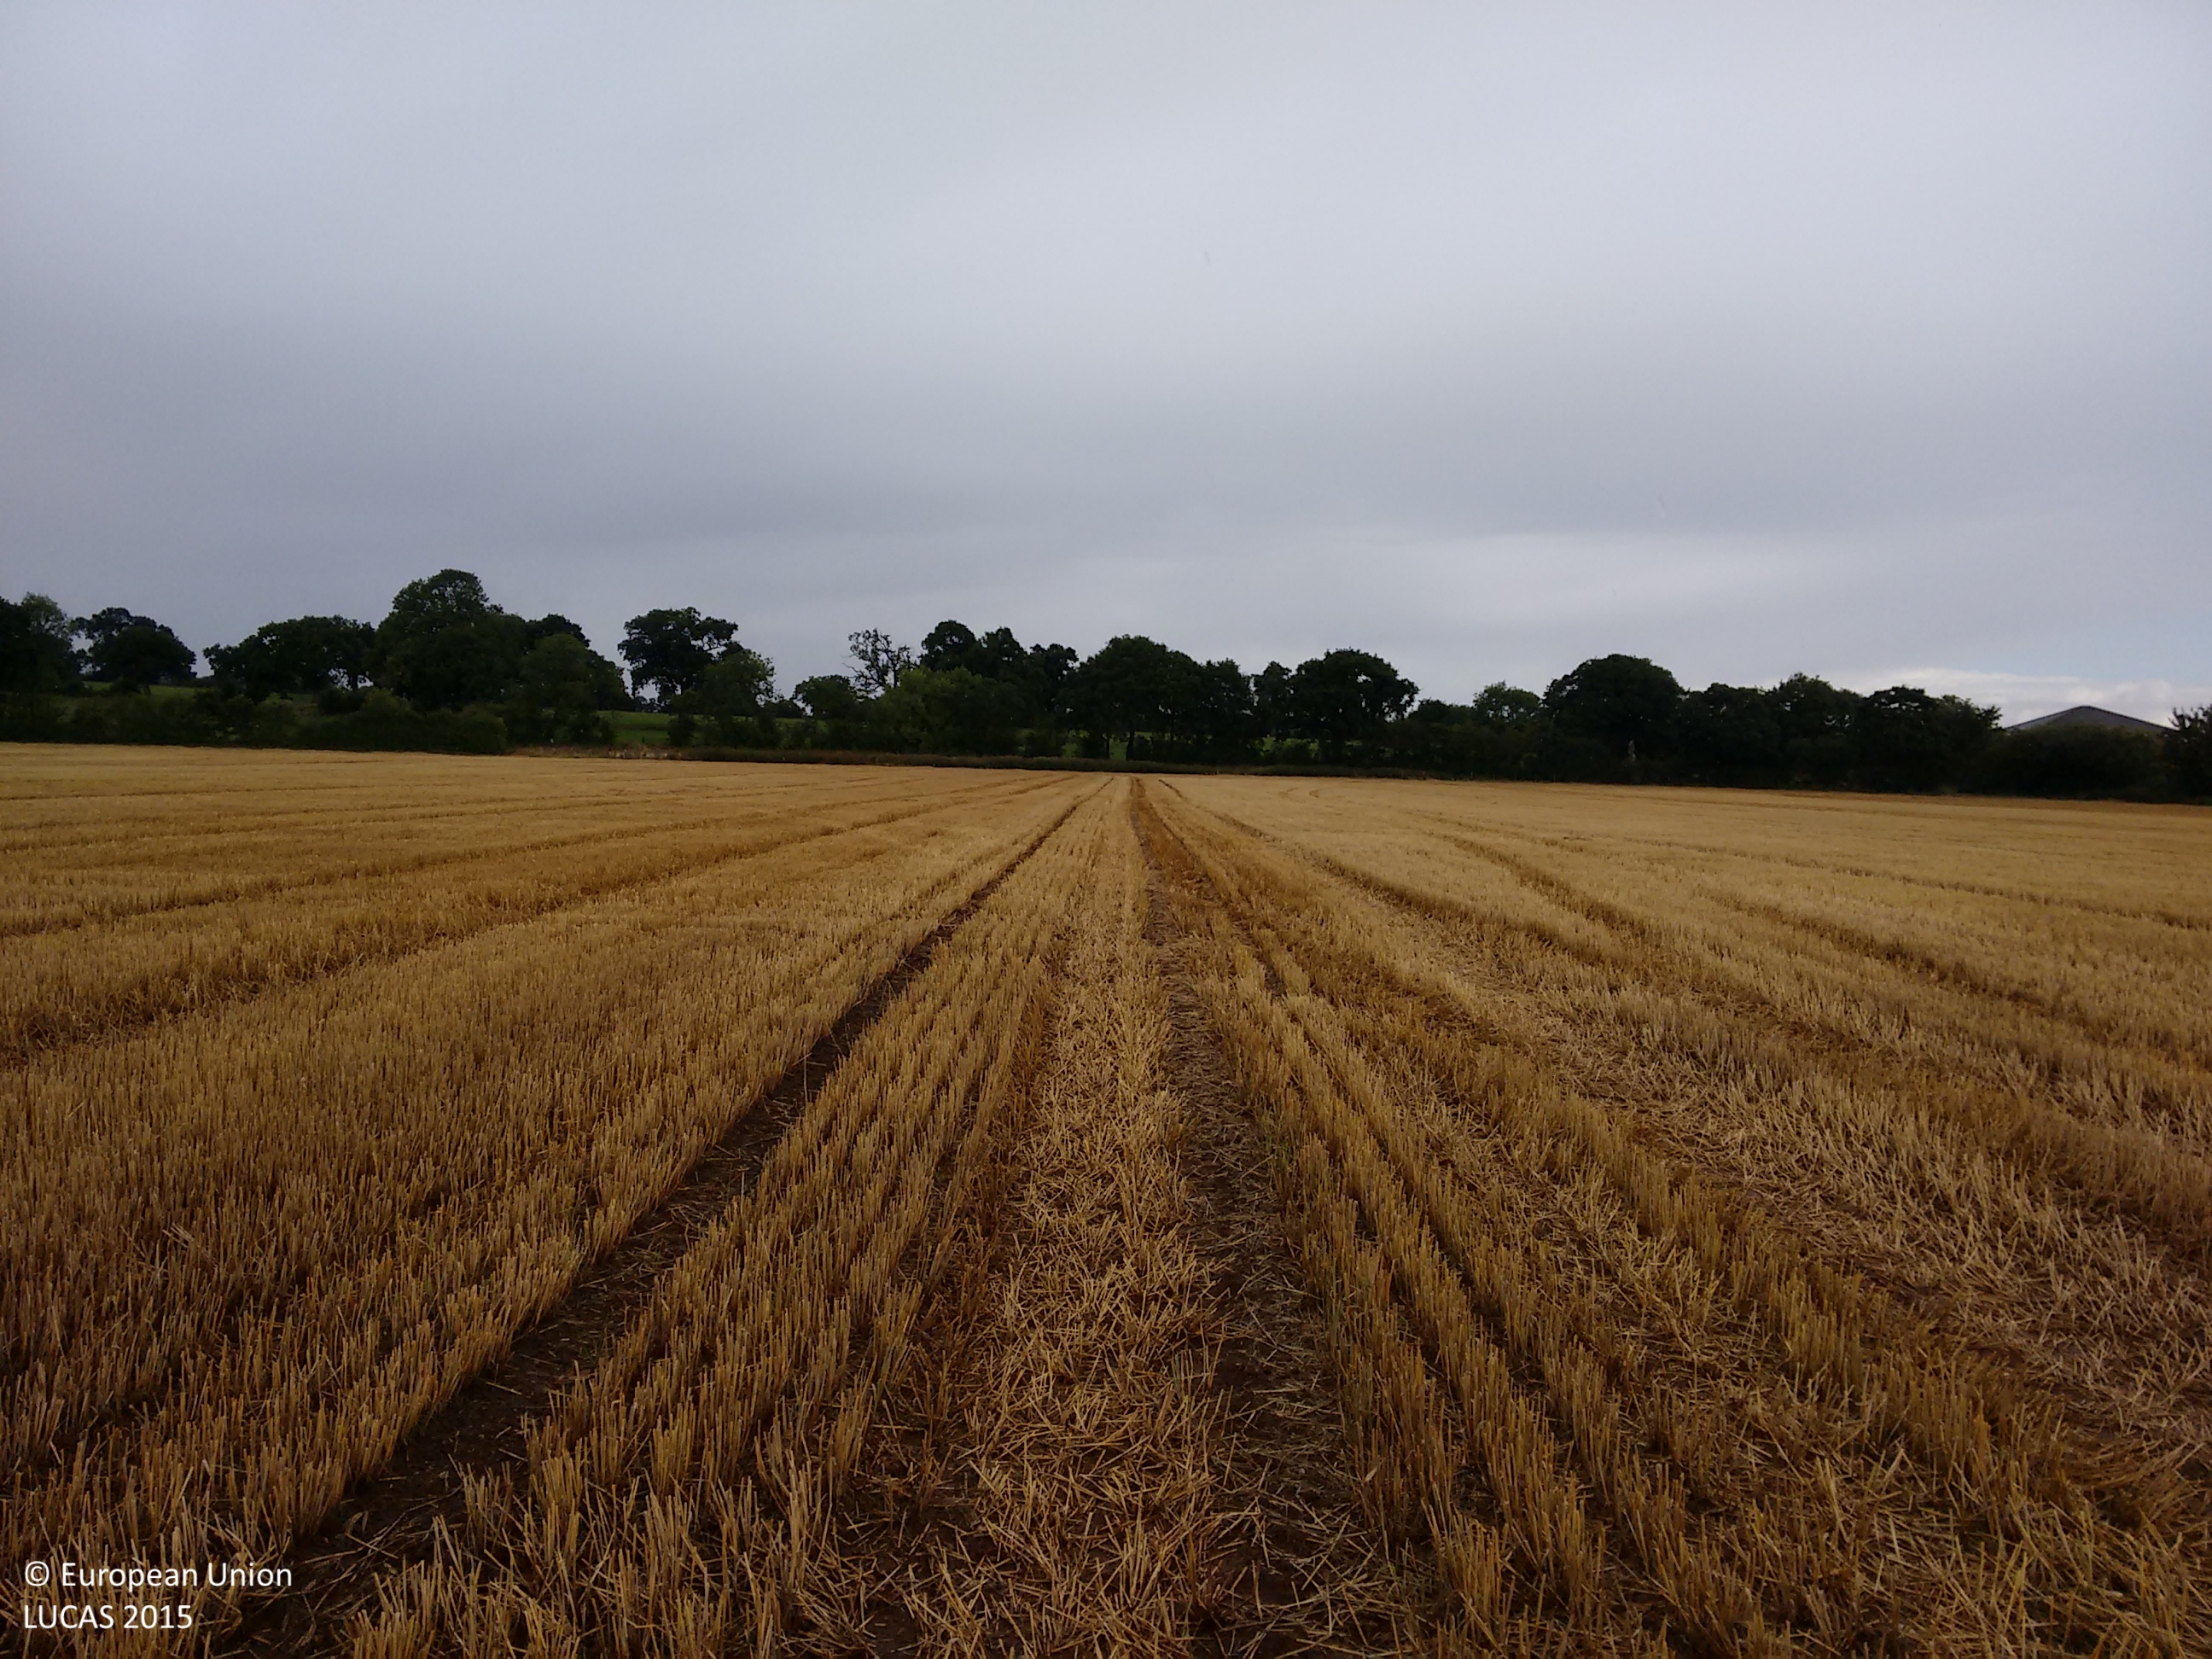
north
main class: Cropland
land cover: Barley
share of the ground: > 75 %
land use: Agriculture (excluding fallow land and kitchen gardens)
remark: Harvested field
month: September
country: GB
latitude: 53.0316
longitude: -2.9422
